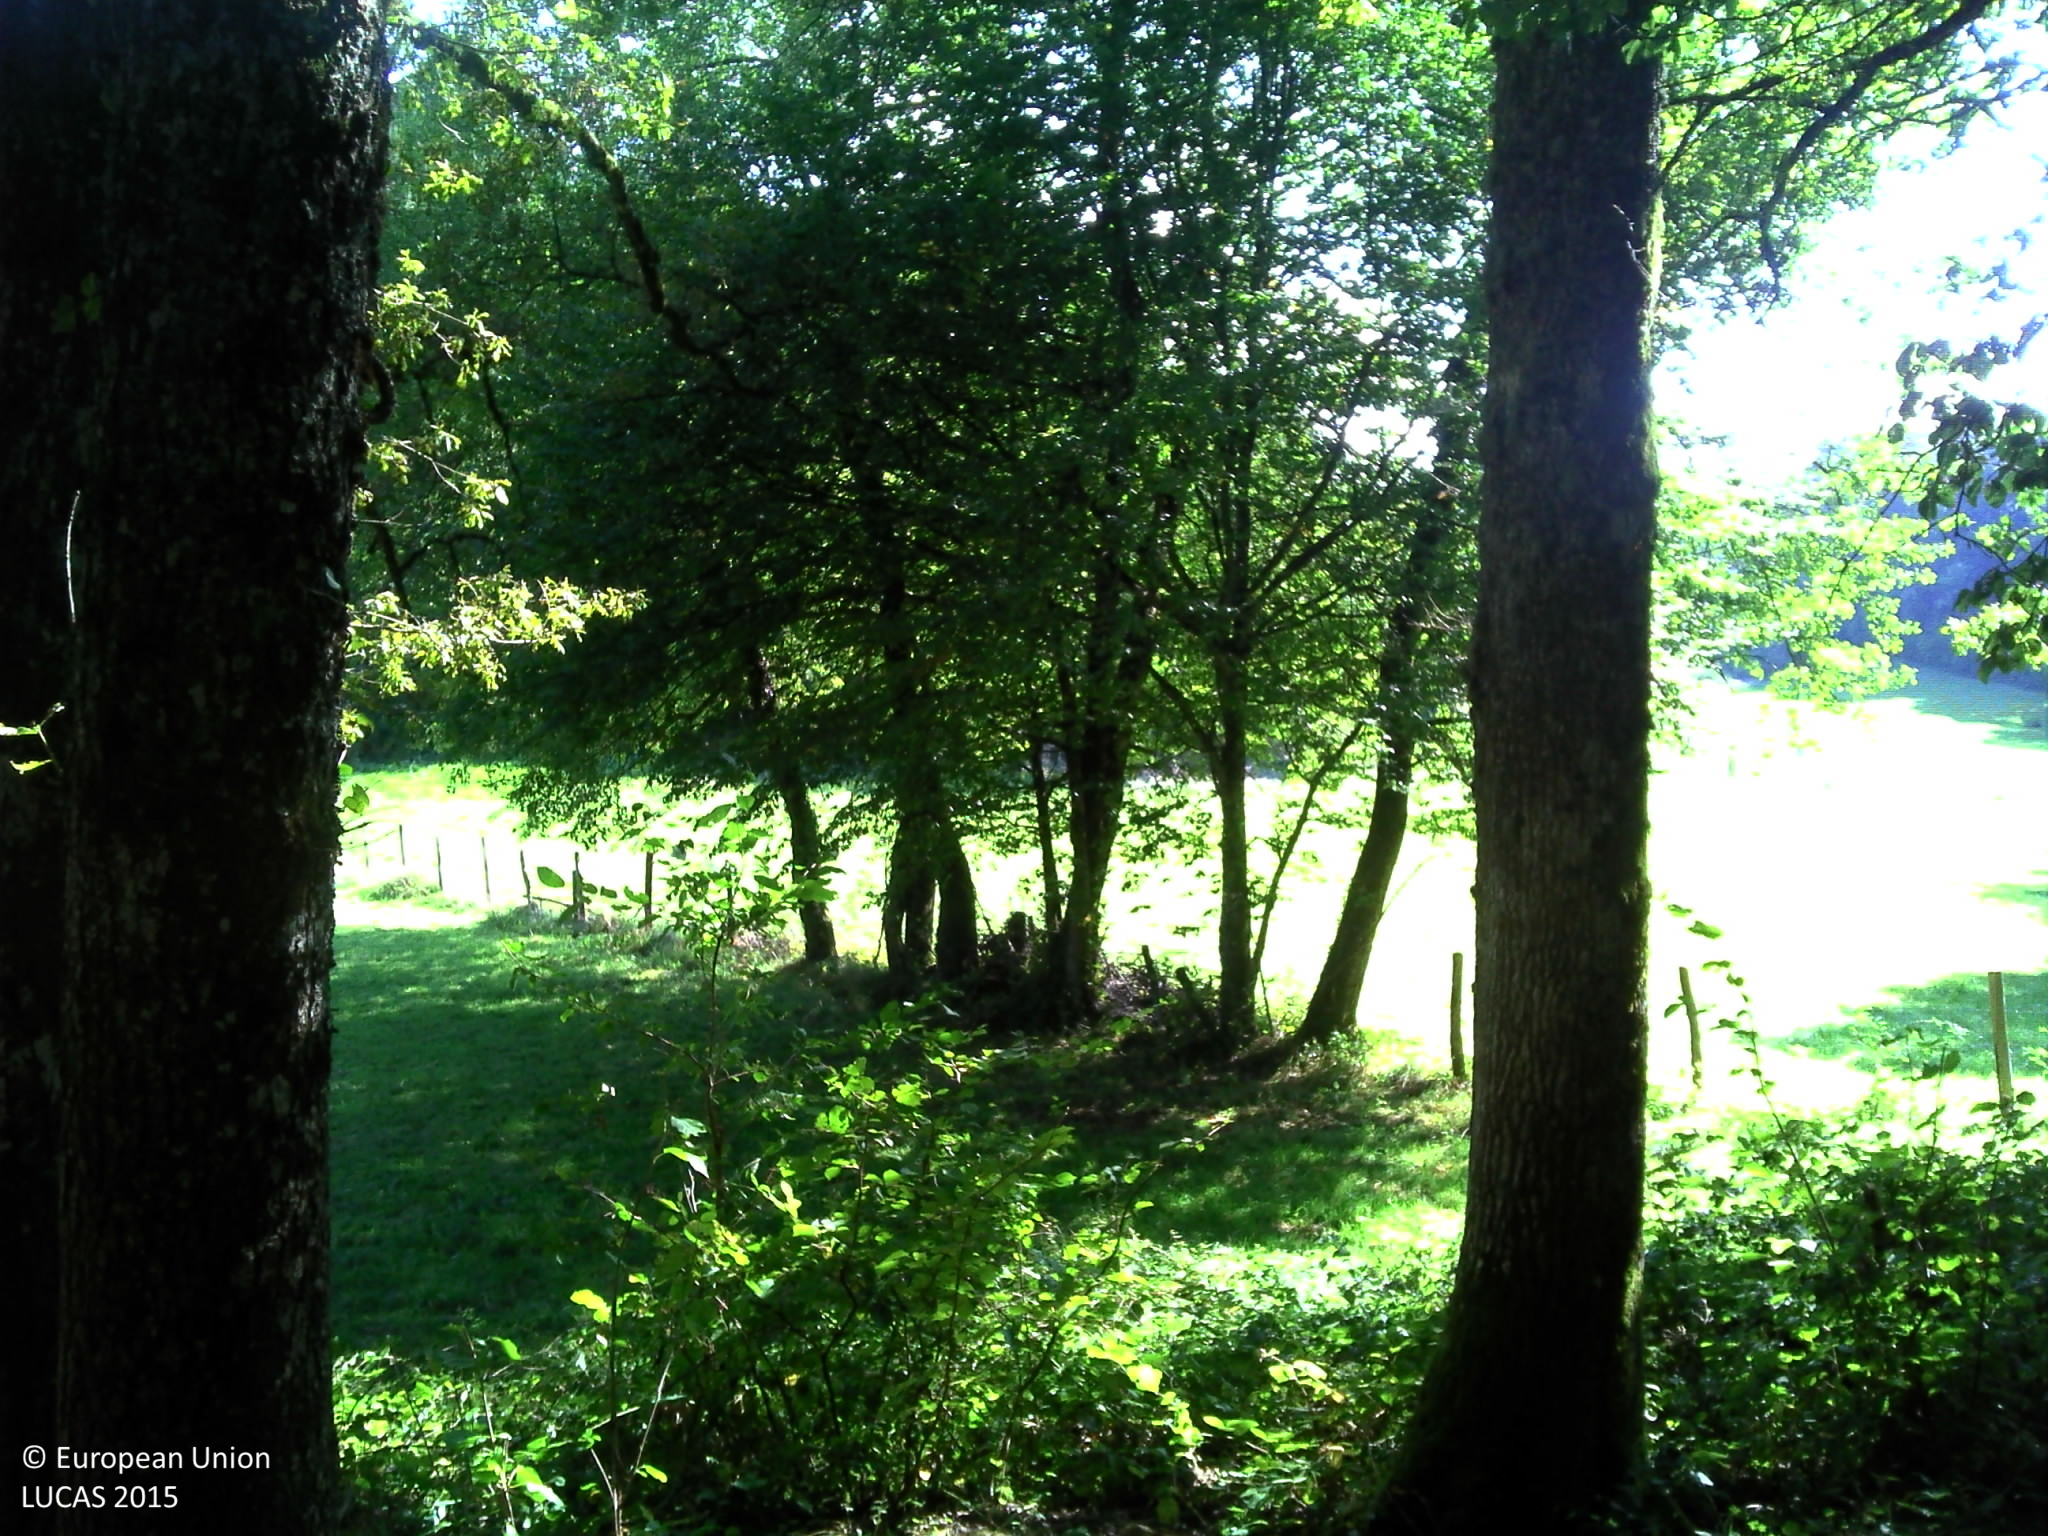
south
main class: Woodland
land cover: Broadleaved woodland
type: beech forest
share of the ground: > 75 %
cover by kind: broadleaved forest trees 90 %, unconsolidated bare surface 10 %
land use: Forestry
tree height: > 5 m
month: September
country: FR
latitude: 47.2431
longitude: 6.3160
